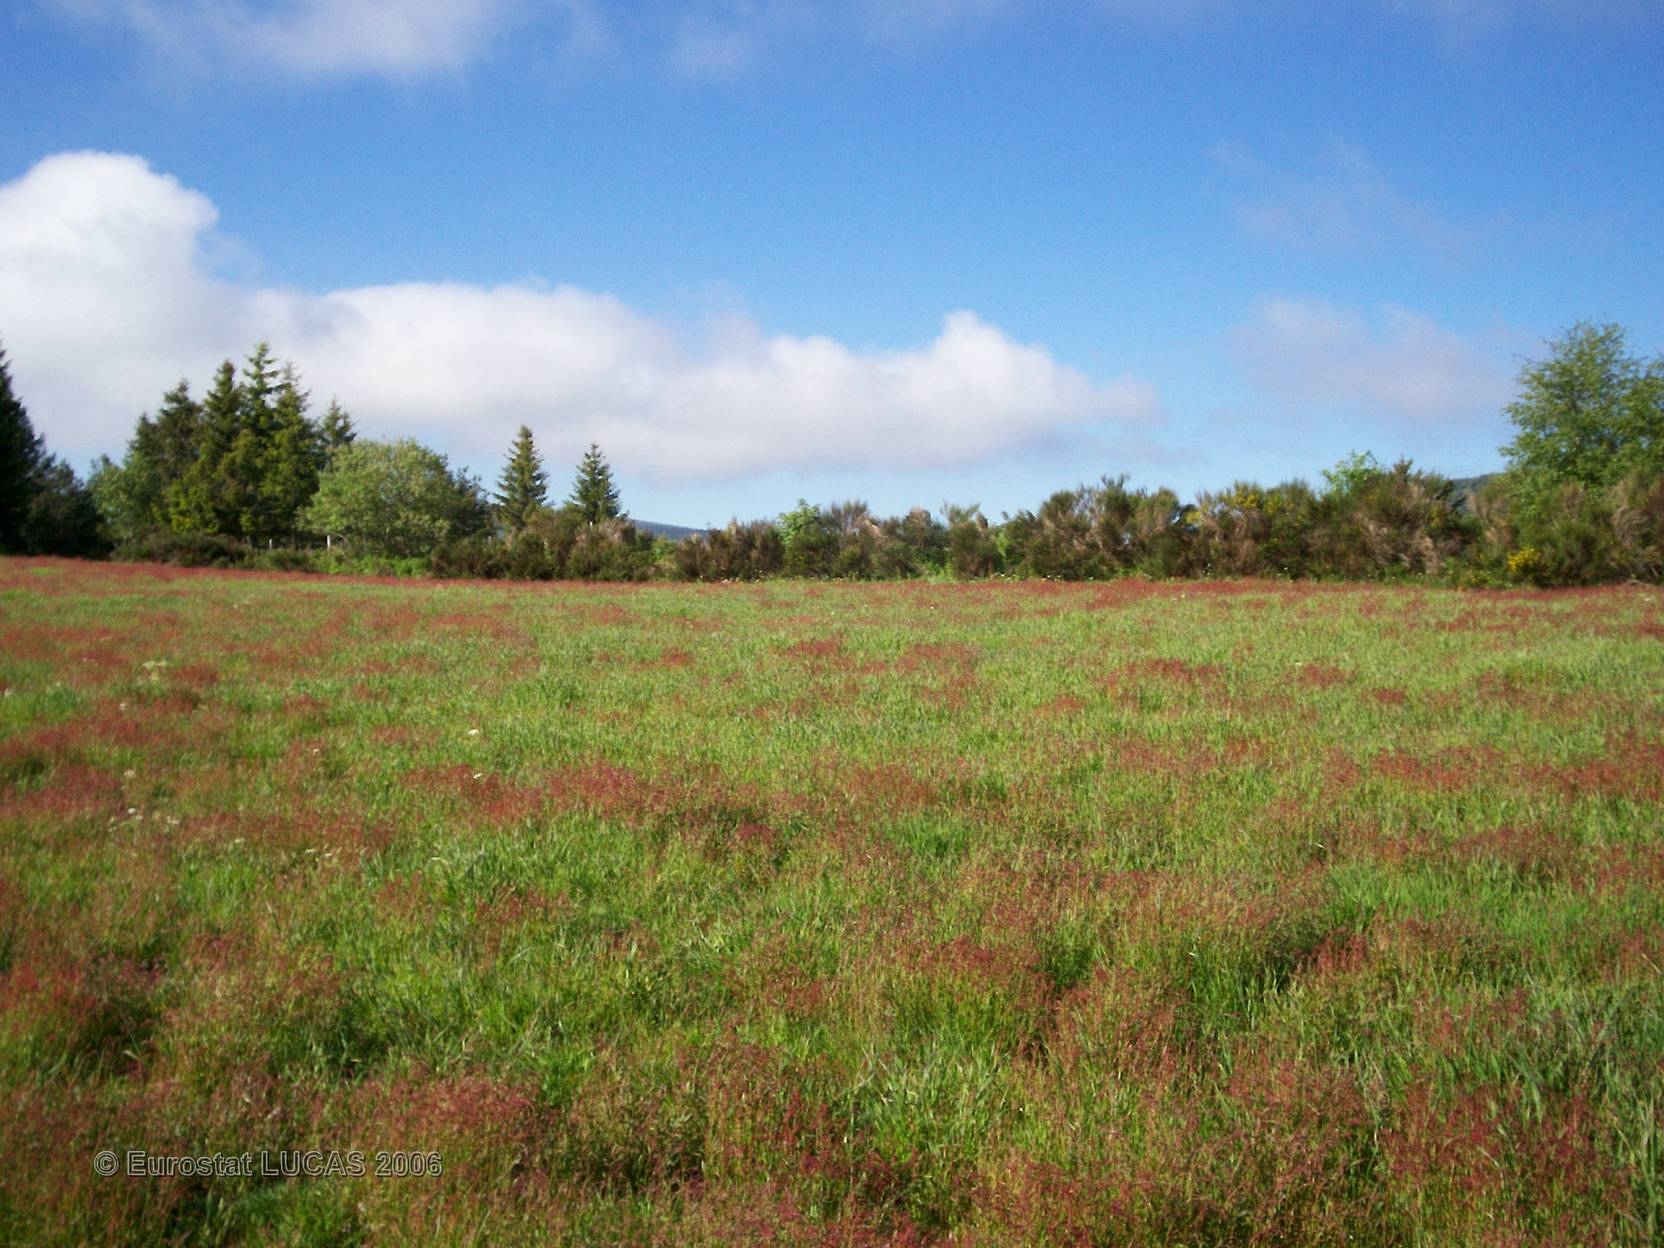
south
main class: Grassland
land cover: Grassland without tree/shrub cover
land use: Agriculture (excluding fallow land and kitchen gardens)
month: June
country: FR
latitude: 44.9526
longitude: 3.3741
